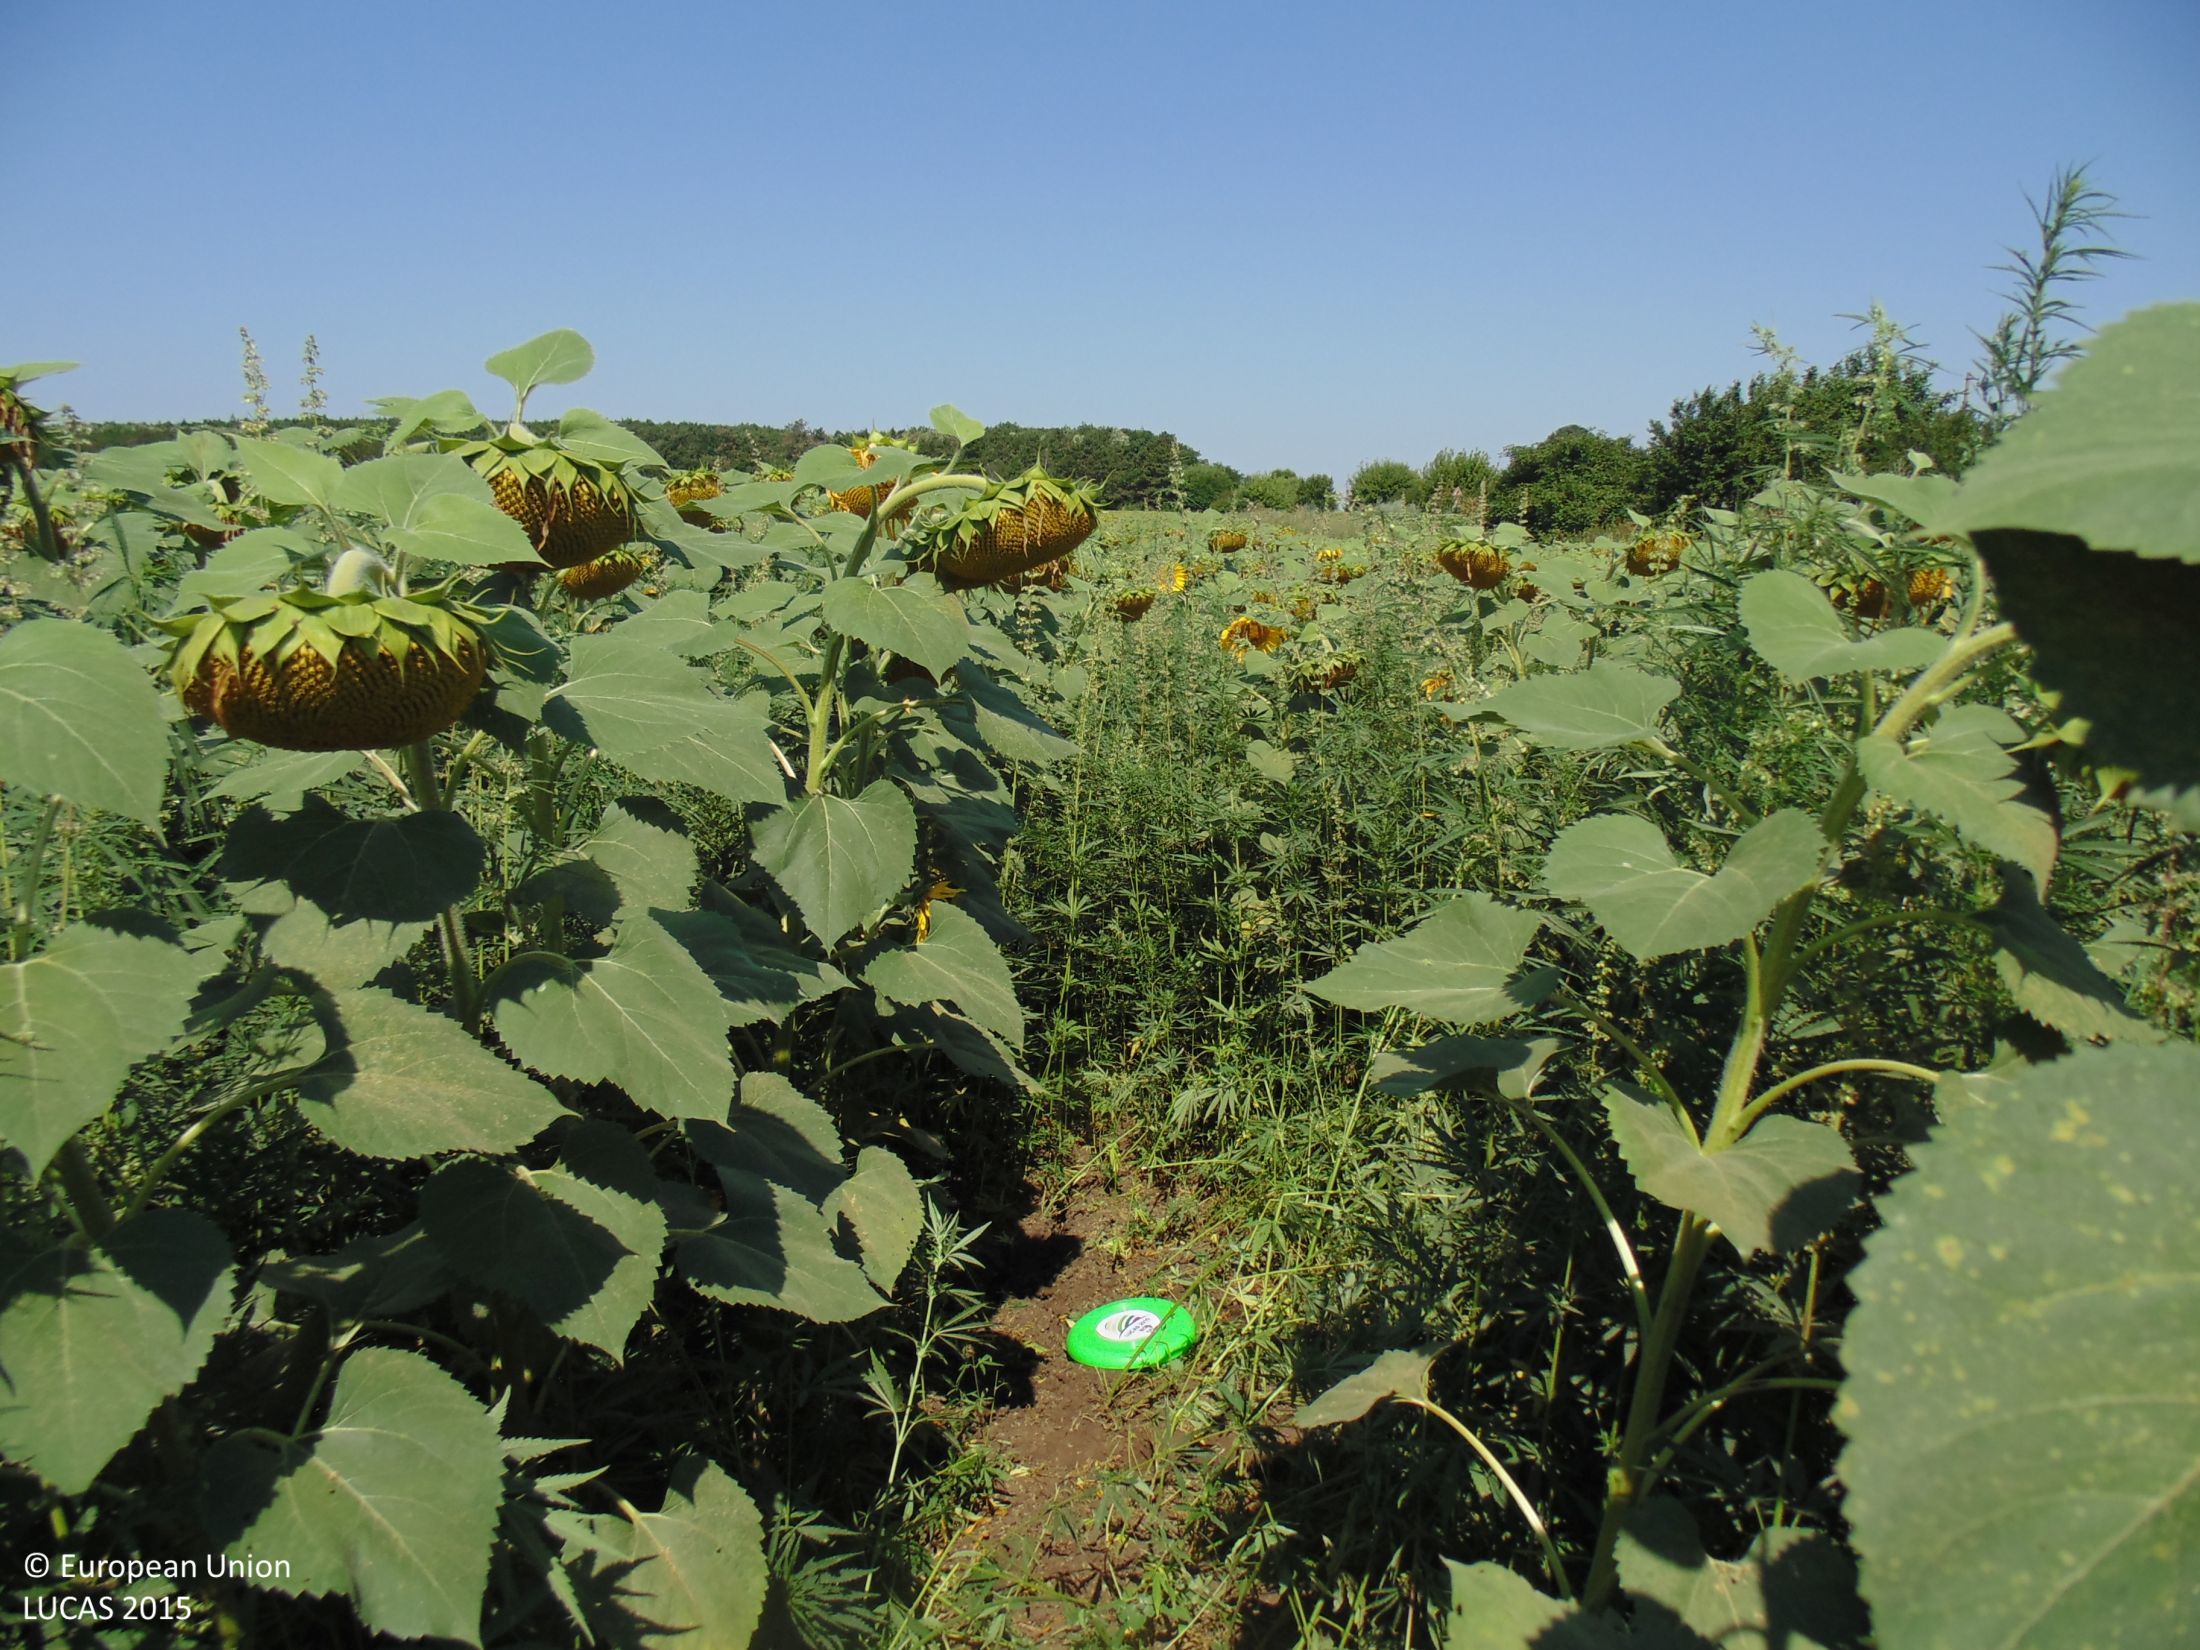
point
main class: Cropland
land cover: Sunflower
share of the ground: > 75 %
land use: Agriculture (excluding fallow land and kitchen gardens)
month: July
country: BG
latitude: 43.6077
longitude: 27.6939
